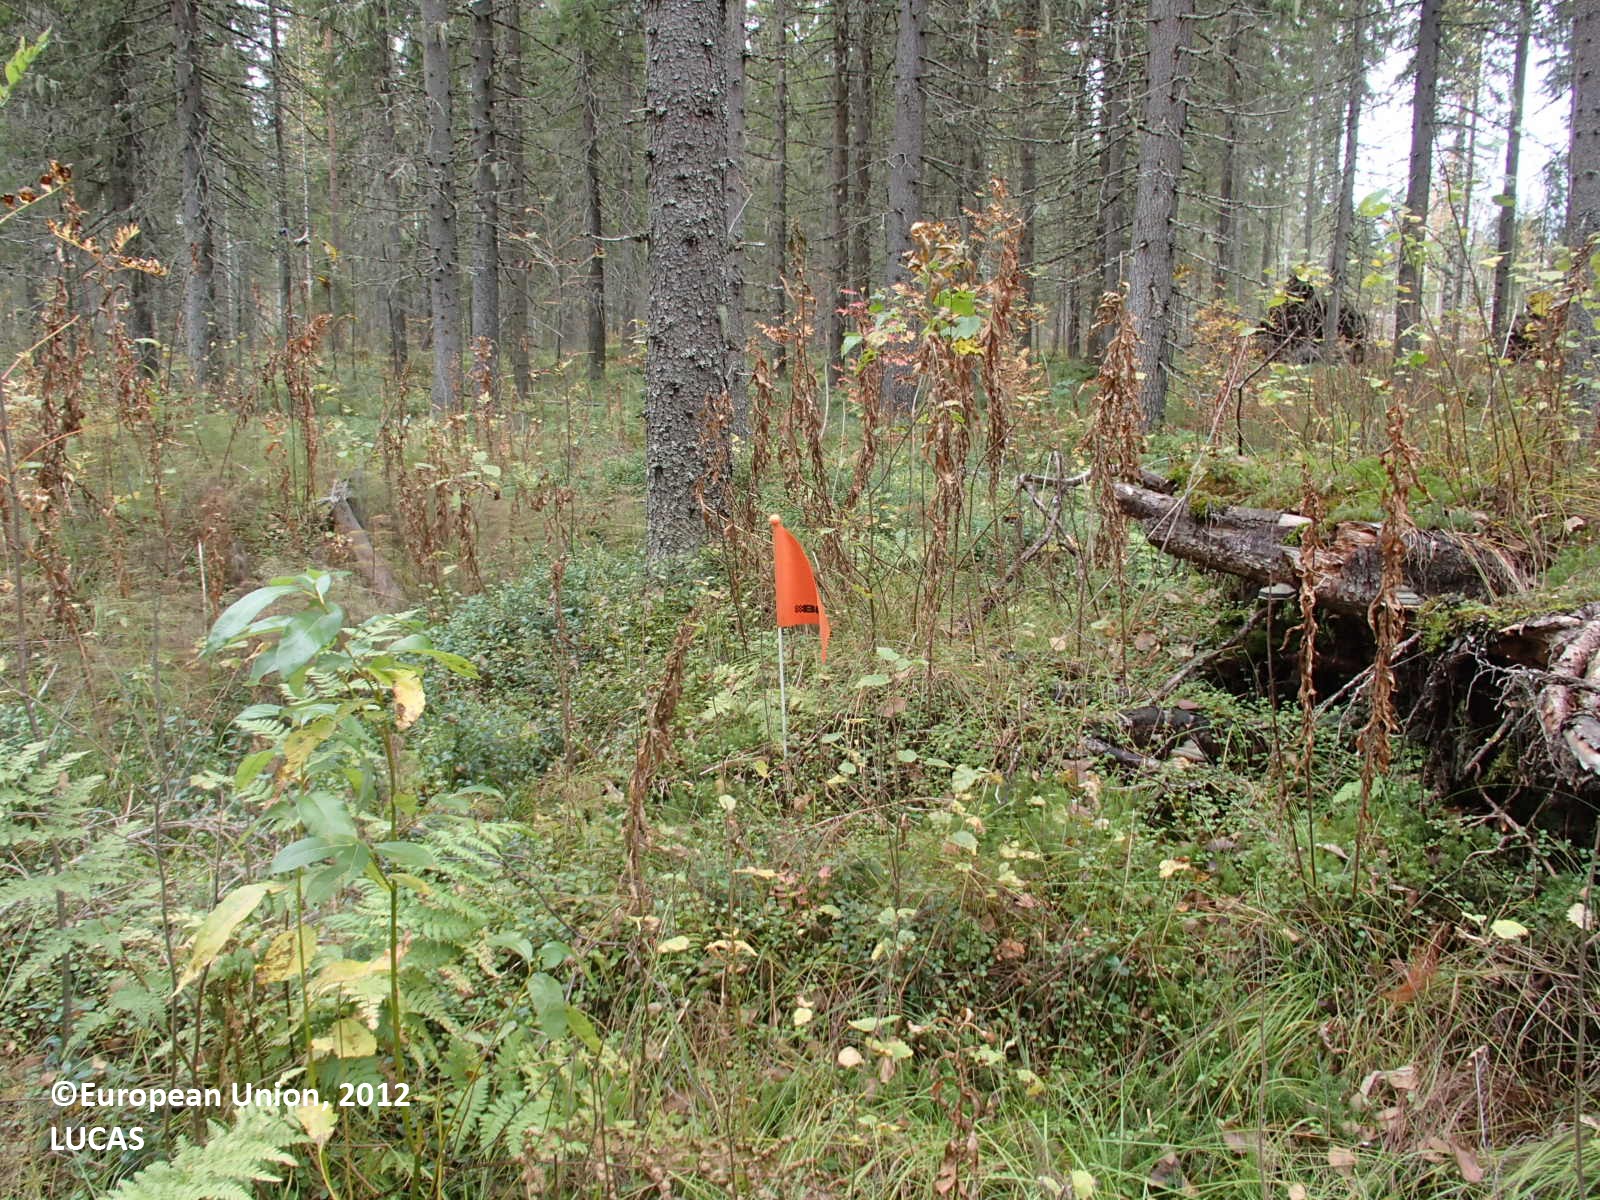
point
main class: Woodland
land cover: Spruce dominated coniferous woodland
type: boreal forest
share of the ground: 50 - 75 %
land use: Forestry
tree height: > 5 m
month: September
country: FI
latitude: 63.5387
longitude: 26.0247
